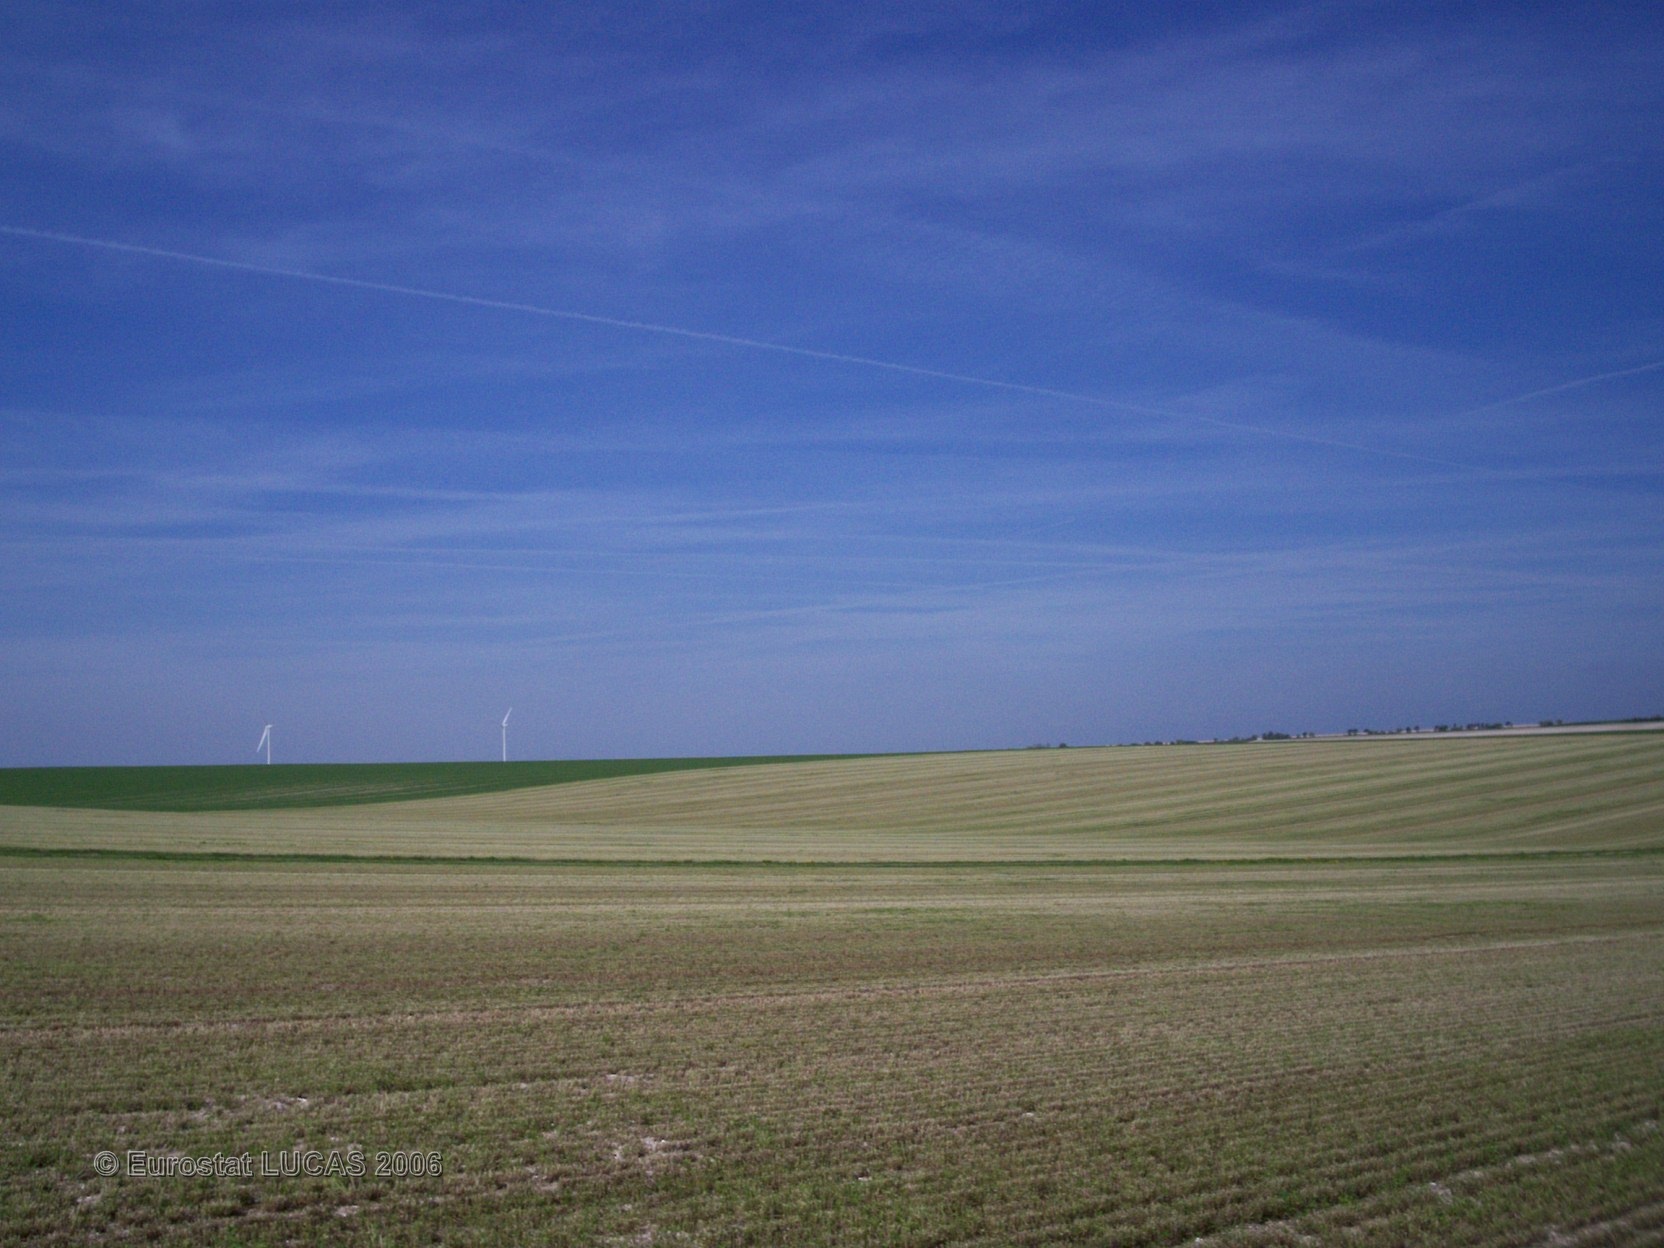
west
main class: Cropland
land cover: Lucerne
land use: Agriculture (excluding fallow land and kitchen gardens)
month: May
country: FR
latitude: 48.8399
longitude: 4.4239
